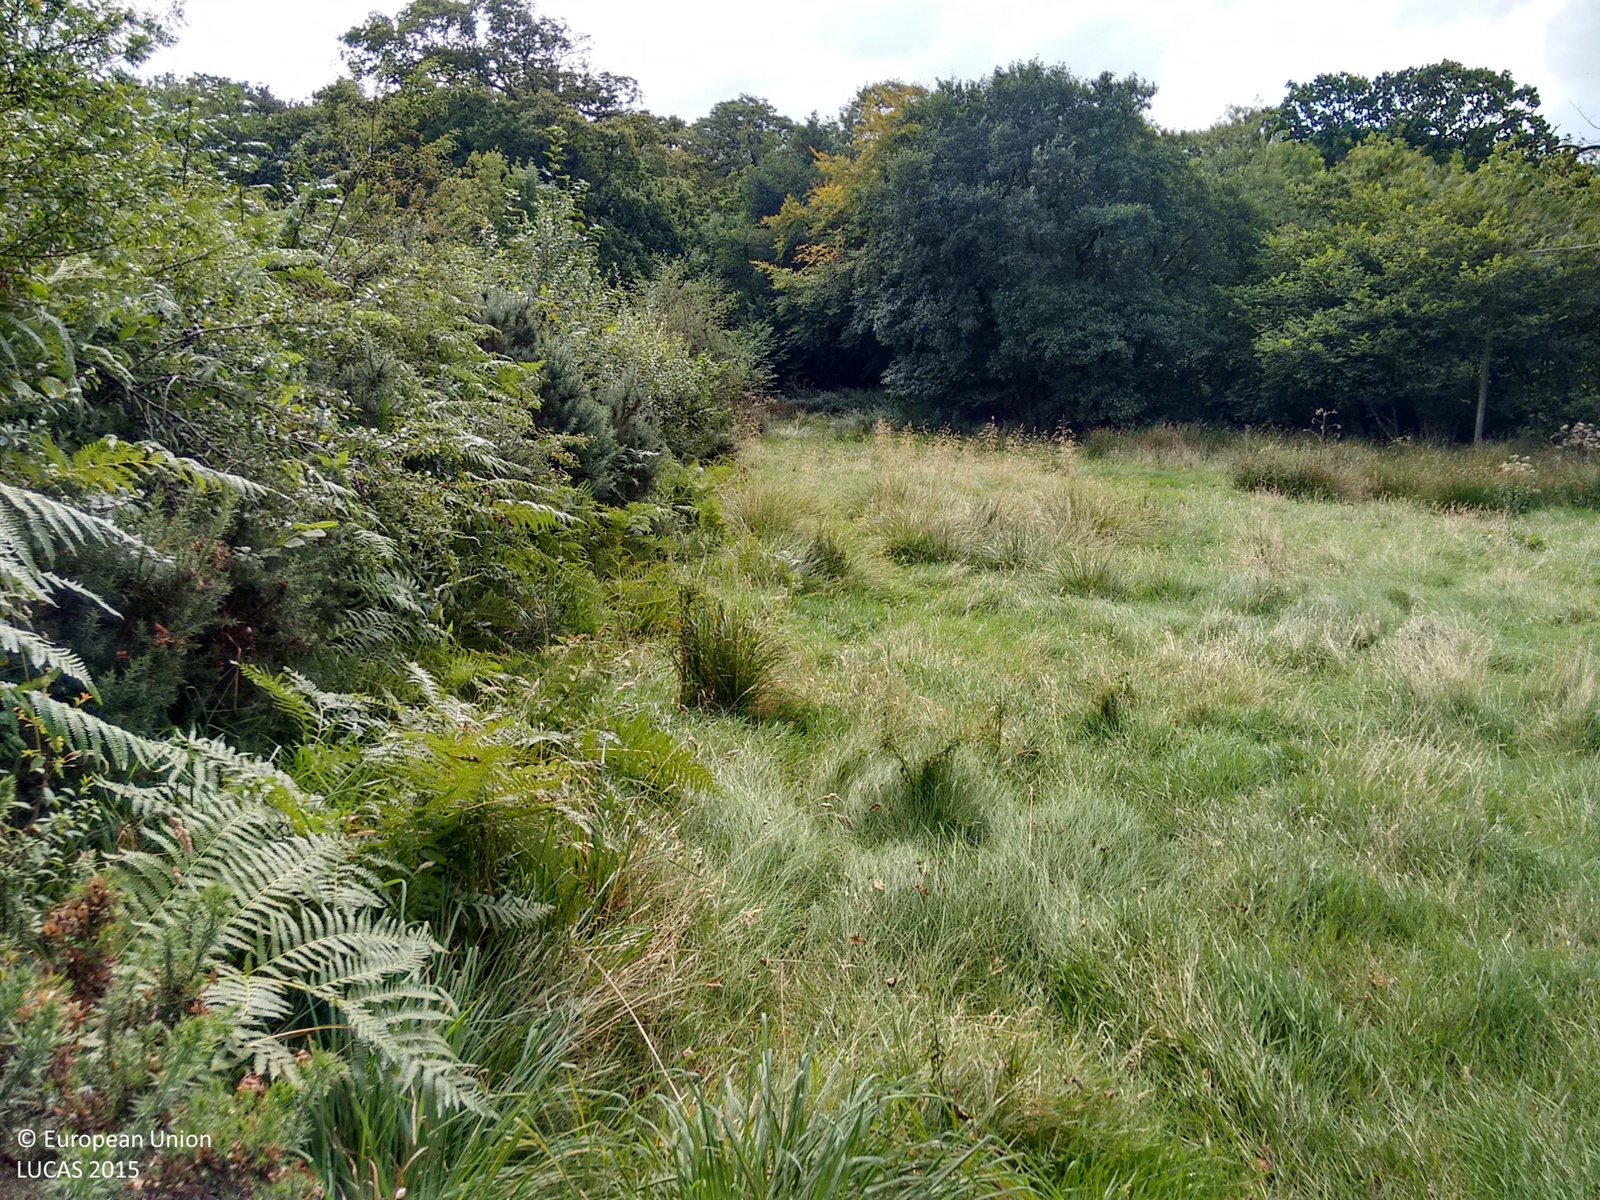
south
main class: Grassland
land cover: Grassland without tree/shrub cover
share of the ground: > 75 %
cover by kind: herbaceous plants 100 %
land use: Agriculture (excluding fallow land and kitchen gardens)
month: September
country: GB
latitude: 50.9406
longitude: -4.2891
